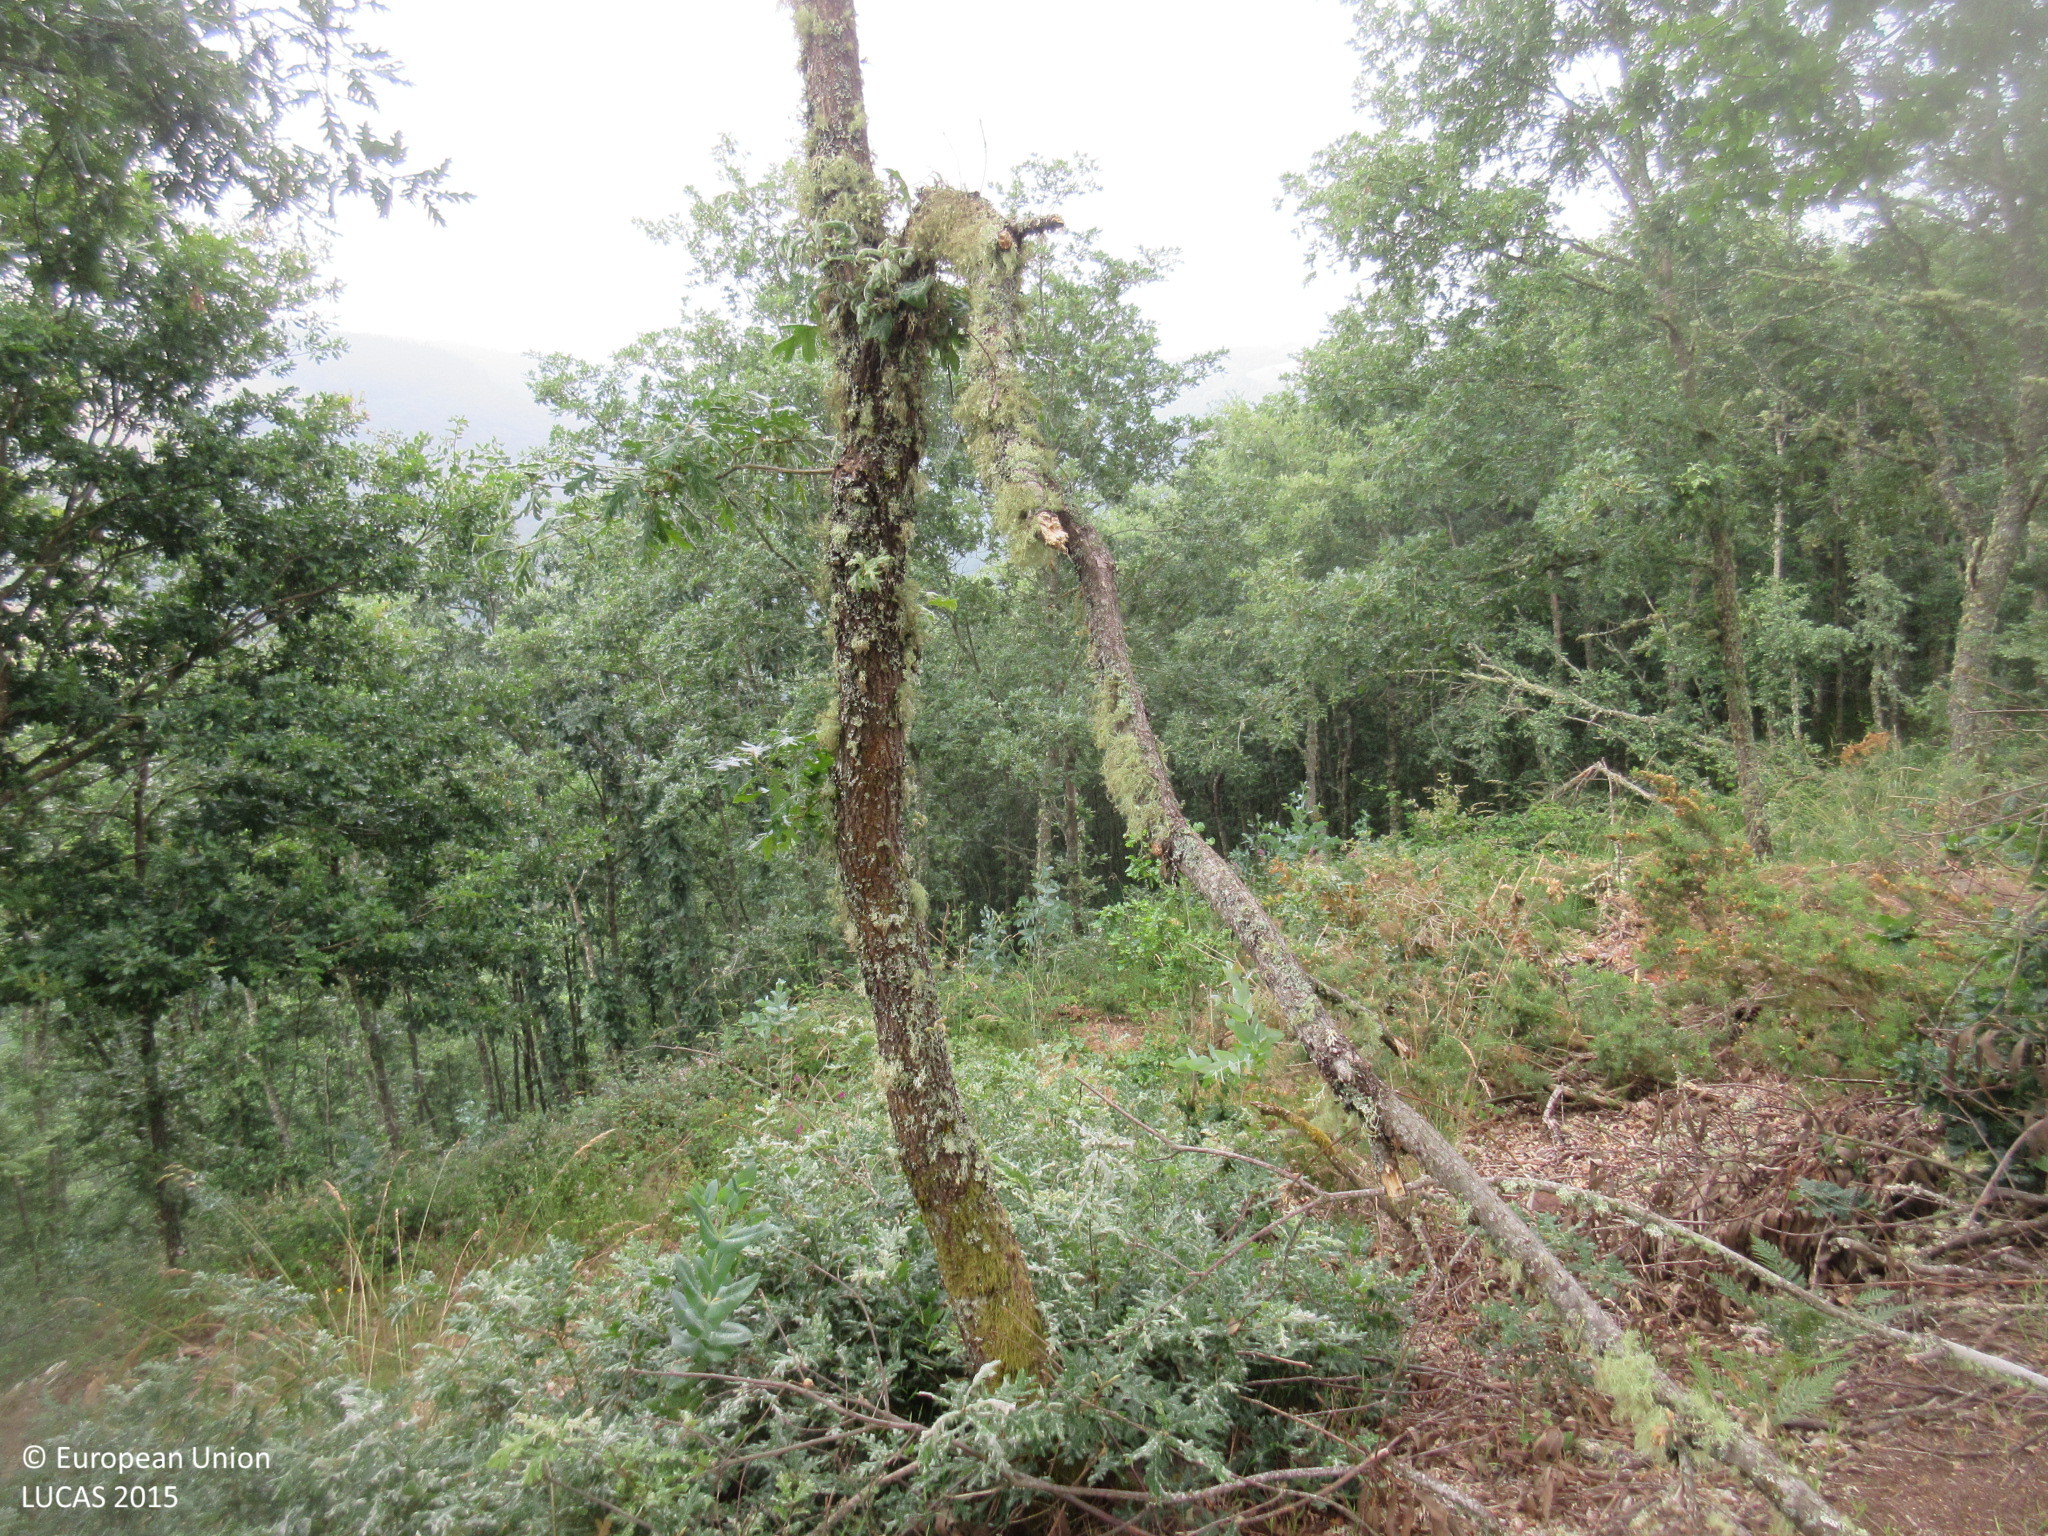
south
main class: Woodland
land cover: Broadleaved woodland
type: acidophilous oak and oak-birch forest
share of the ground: > 75 %
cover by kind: broadleaved forest trees 90 %, shrubs 10 %
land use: Forestry
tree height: > 5 m
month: June
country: ES
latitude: 42.9660
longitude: -7.1436
